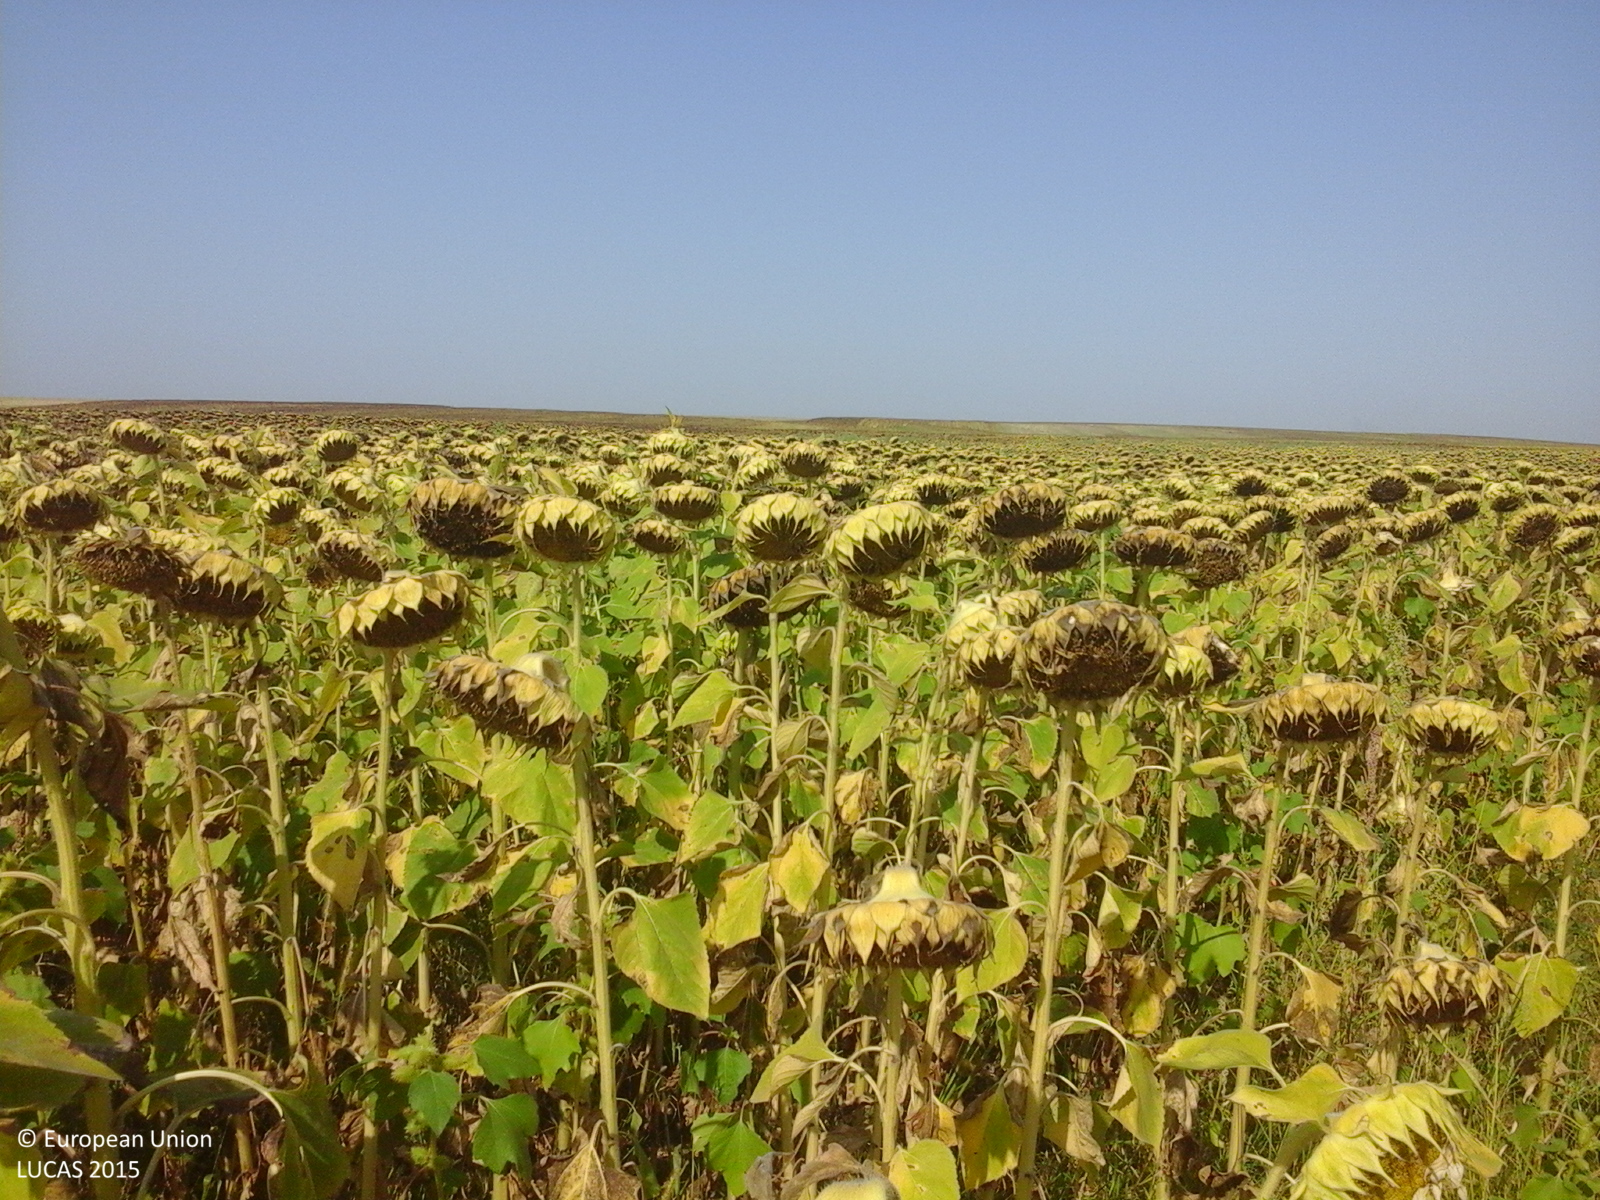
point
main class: Cropland
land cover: Sunflower
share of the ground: > 75 %
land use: Agriculture (excluding fallow land and kitchen gardens)
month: August
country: RO
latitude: 44.1314
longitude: 23.2827
